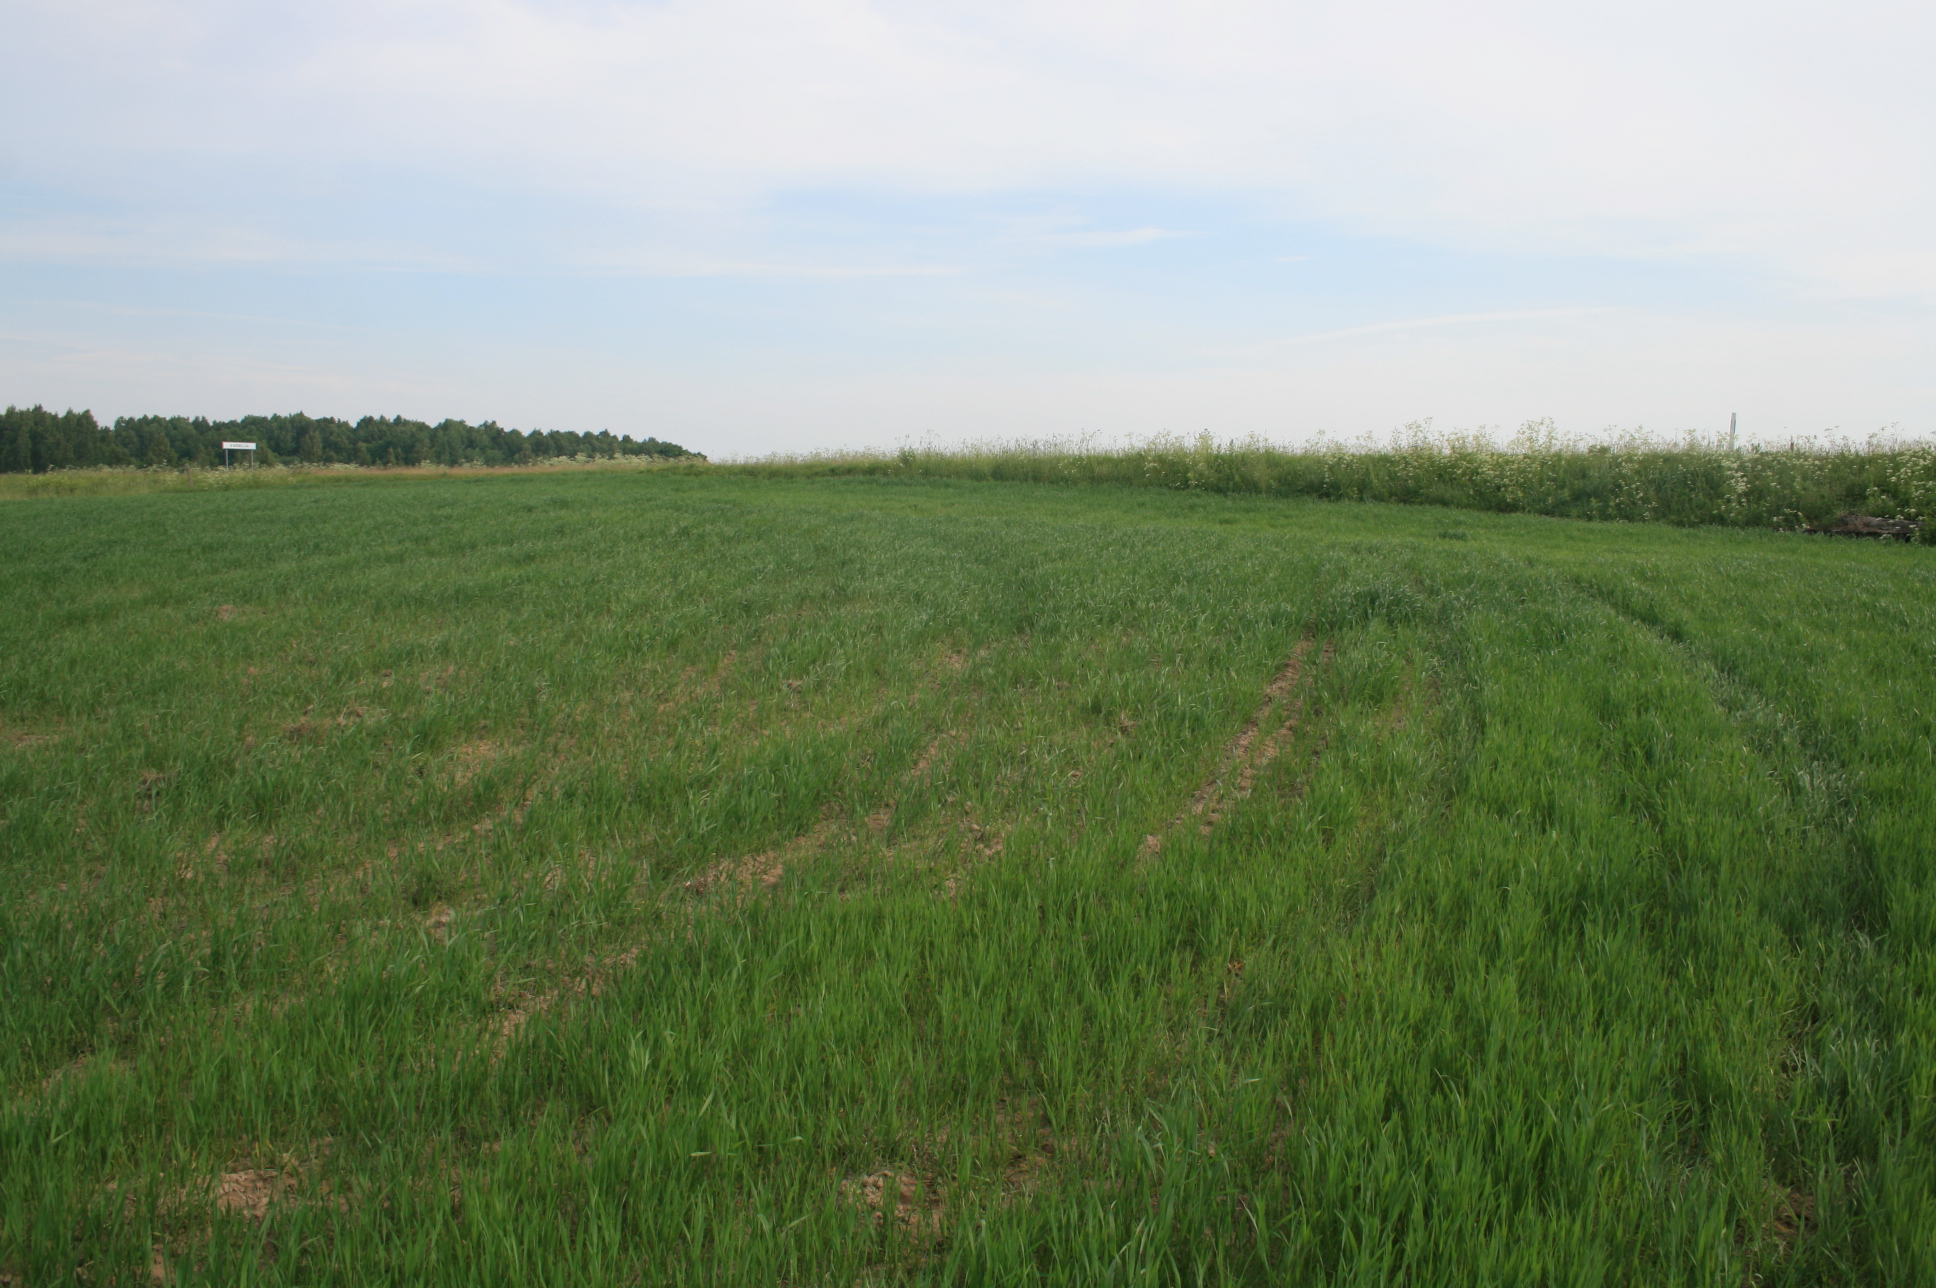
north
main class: Cropland
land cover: Common wheat
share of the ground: > 75 %
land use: Agriculture (excluding fallow land and kitchen gardens)
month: June
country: LT
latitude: 55.7415
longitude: 22.2736
